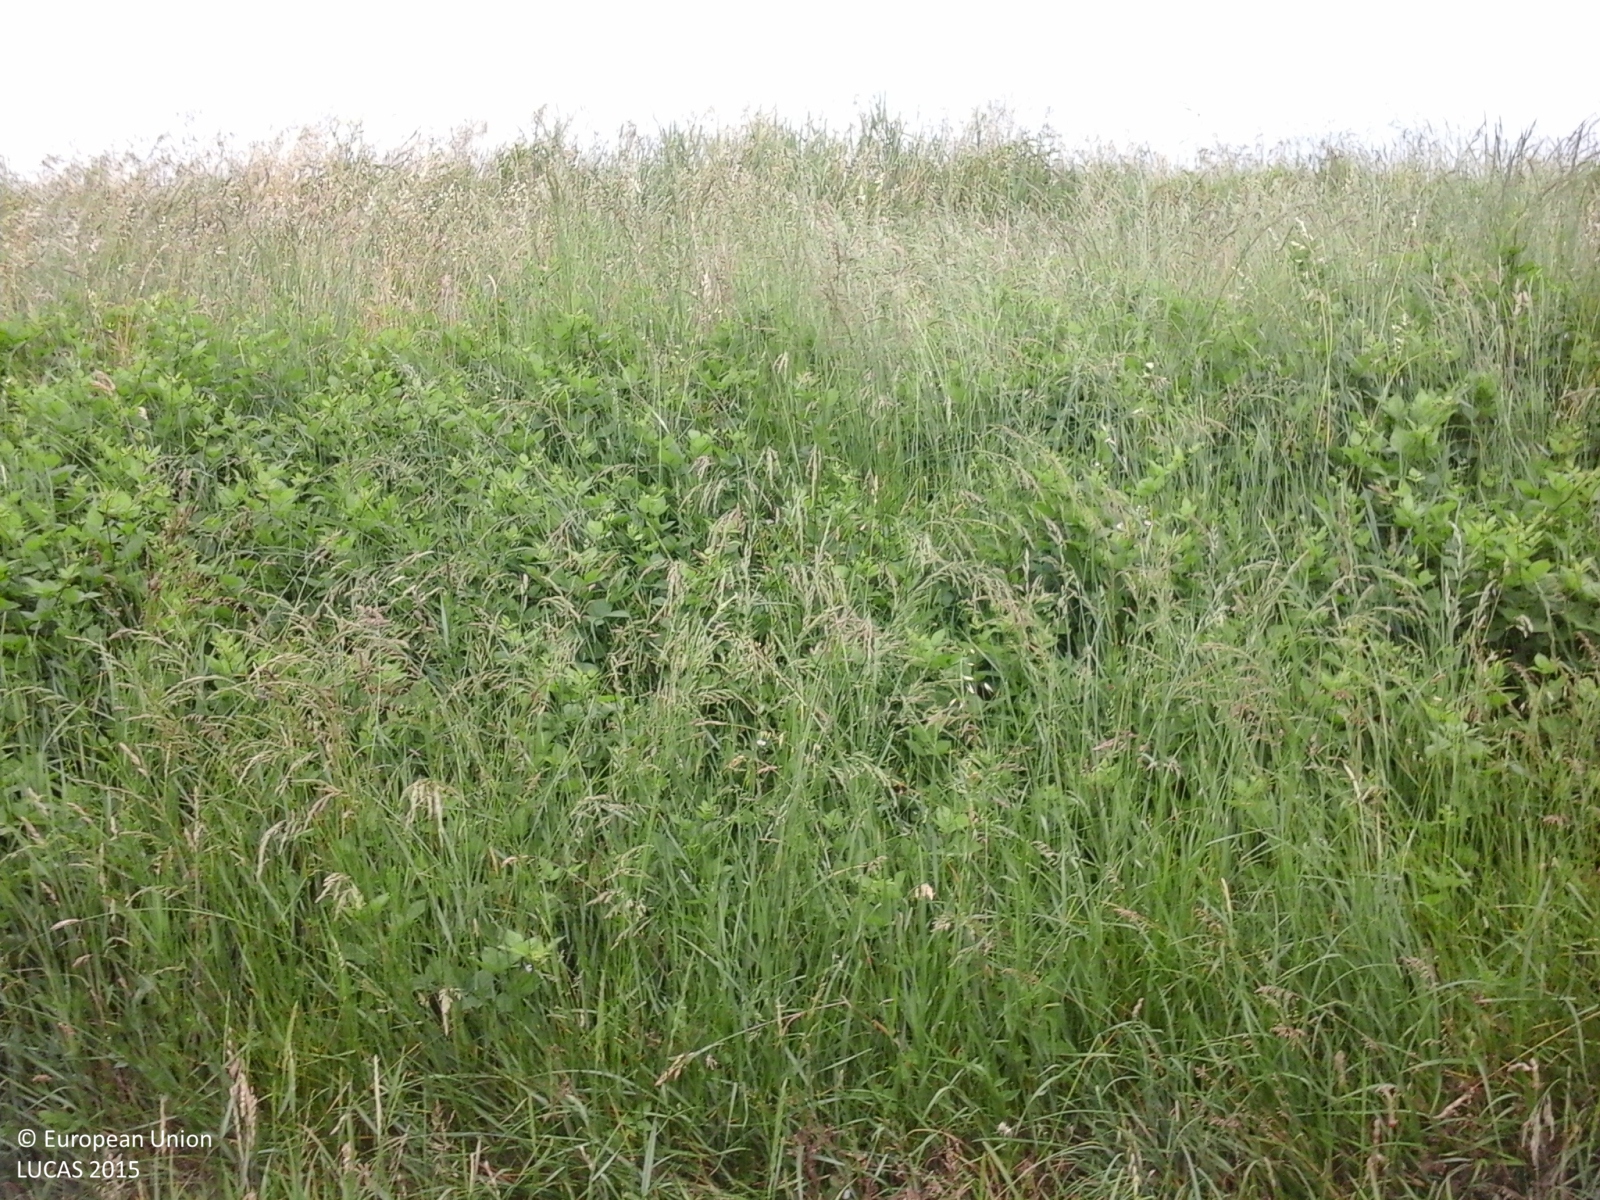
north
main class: Cropland
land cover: Common wheat
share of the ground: > 75 %
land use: Agriculture (excluding fallow land and kitchen gardens)
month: May
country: IT
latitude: 45.5326
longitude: 12.3398
